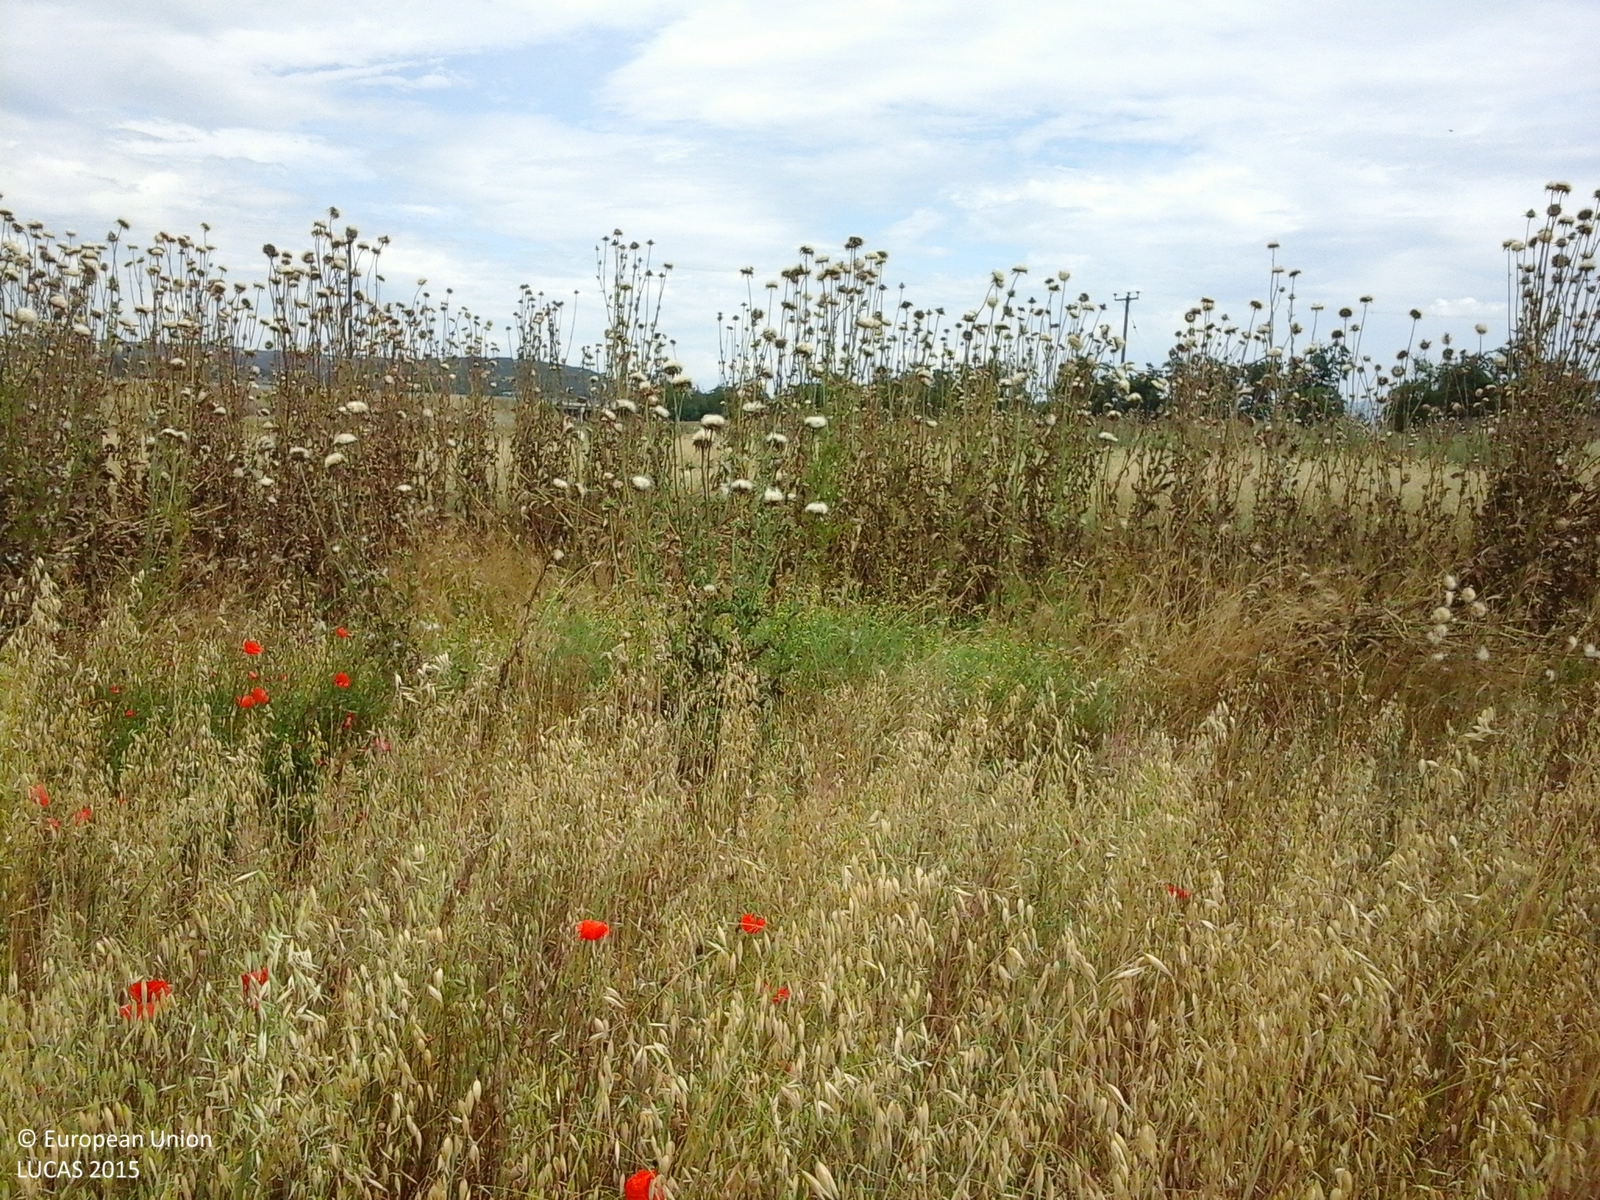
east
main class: Grassland
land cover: Grassland without tree/shrub cover
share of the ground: > 75 %
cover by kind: herbaceous plants 100 %
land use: Semi-natural and natural areas not in use
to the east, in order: Grassland without tree/shrub cover; Spontaneously vegetated surfaces; Electric lines; Tracks; Spontaneously vegetated surfaces; Electric lines; Other bare soil; Paved roads, cycling and walking lanes; Spontaneously vegetated surfaces; Shruby margins
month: June
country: GR
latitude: 40.7123
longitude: 23.1617
